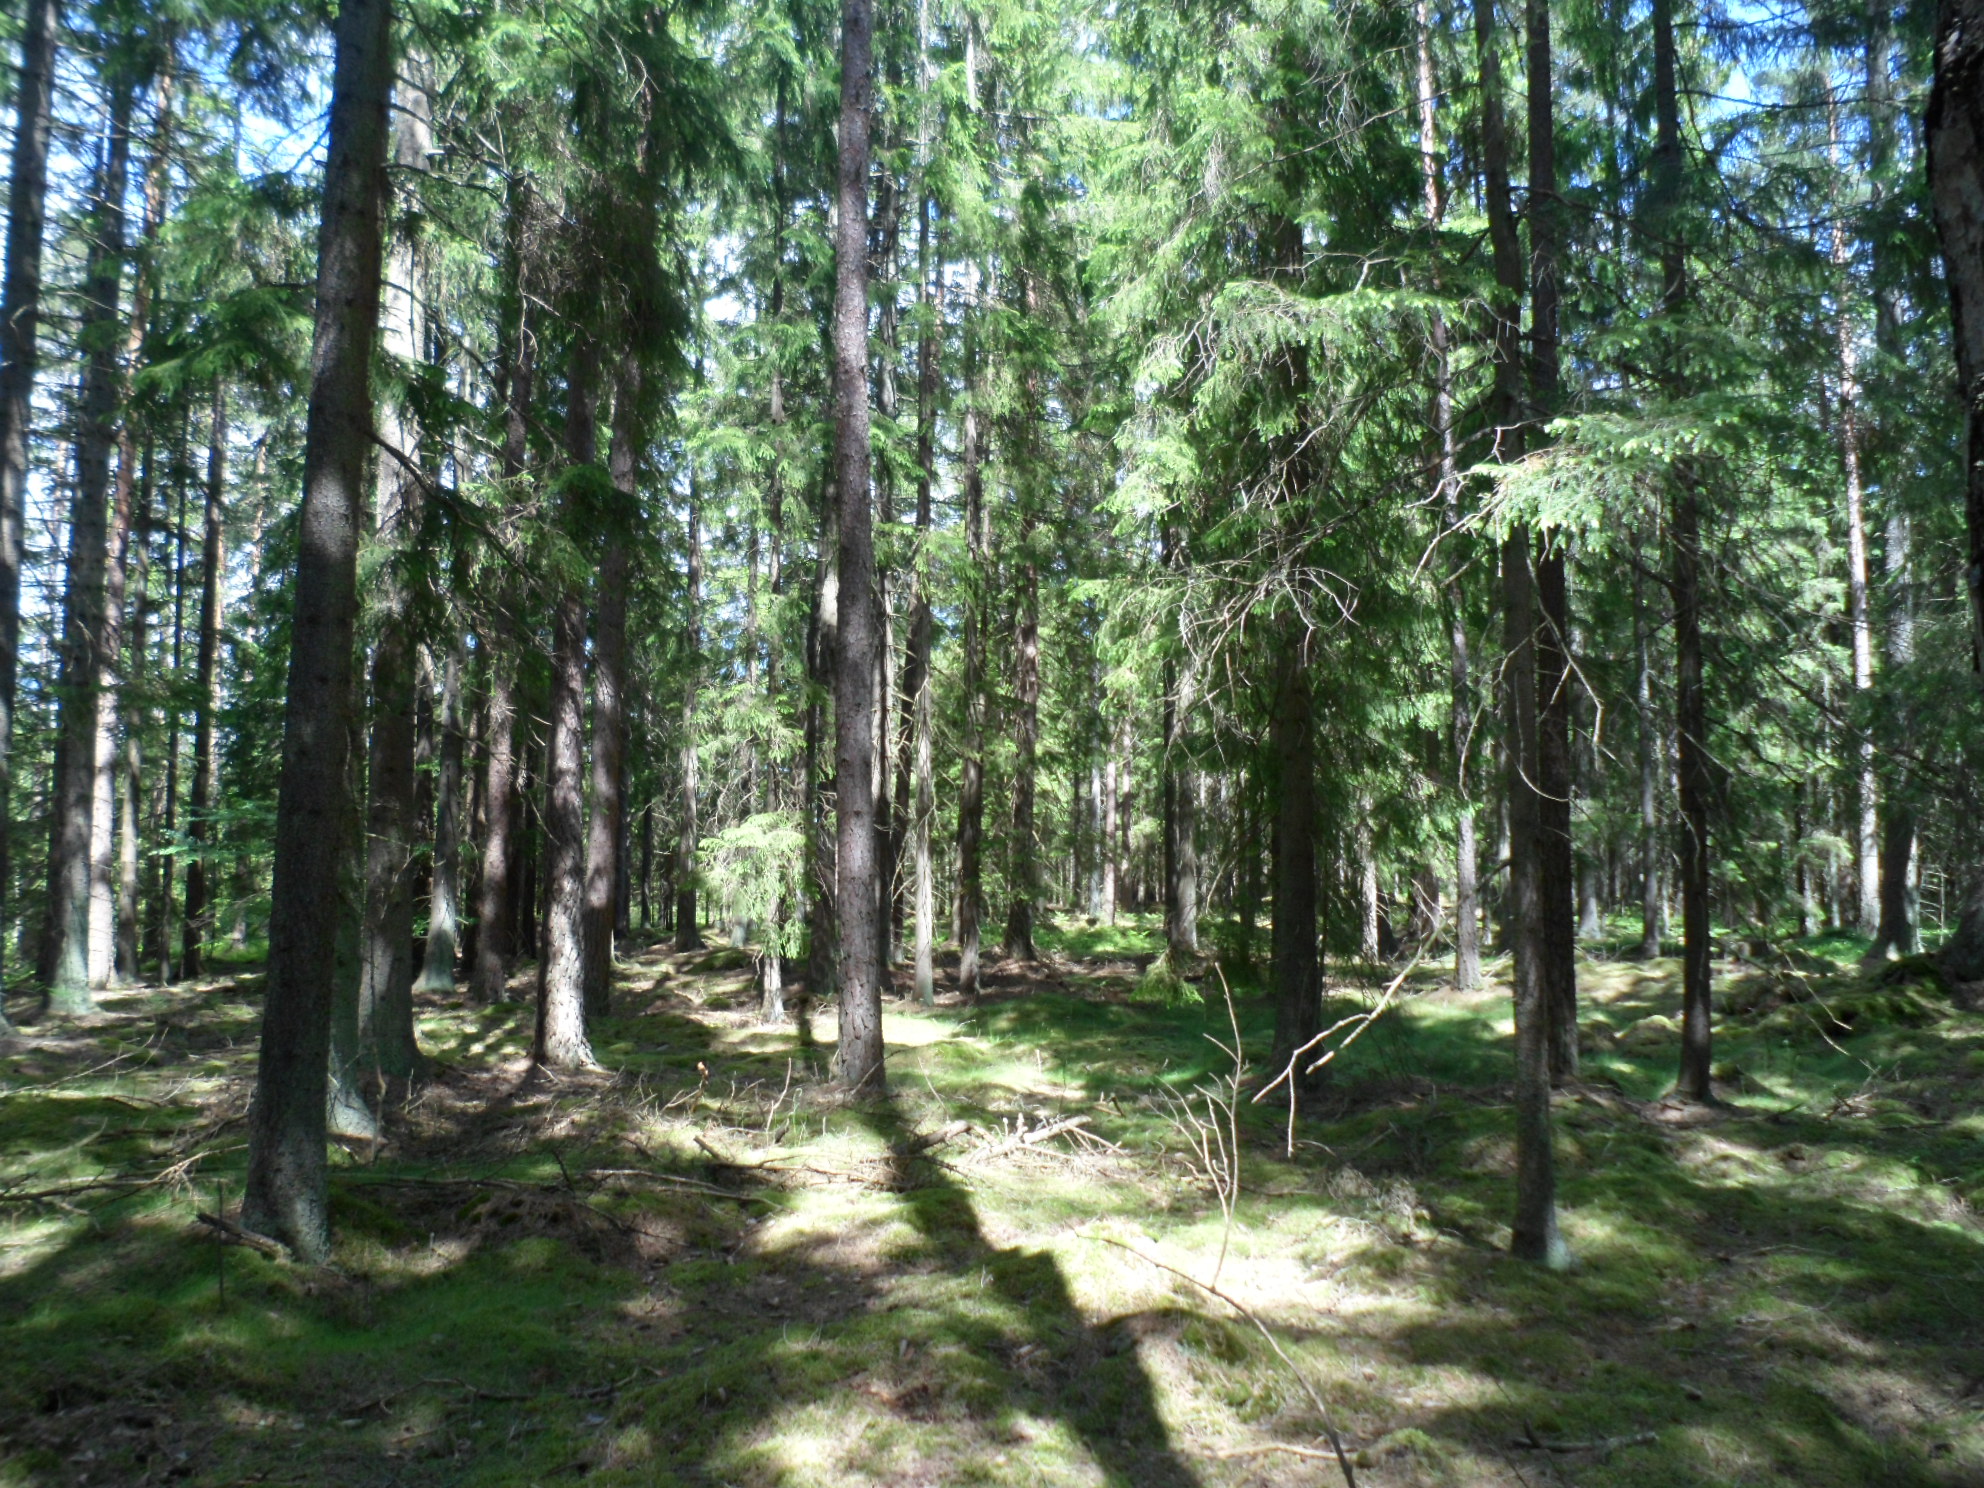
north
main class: Woodland
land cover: Pine dominated coniferous woodland
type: boreal forest
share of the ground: 25 - 50 %
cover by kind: coniferous forest trees 50 %, lichens and mosses 25 %, shrubs 15 %, consolidated bare surface 10 %
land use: Forestry
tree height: > 5 m
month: June
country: SE
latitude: 57.1809
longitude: 14.2146
